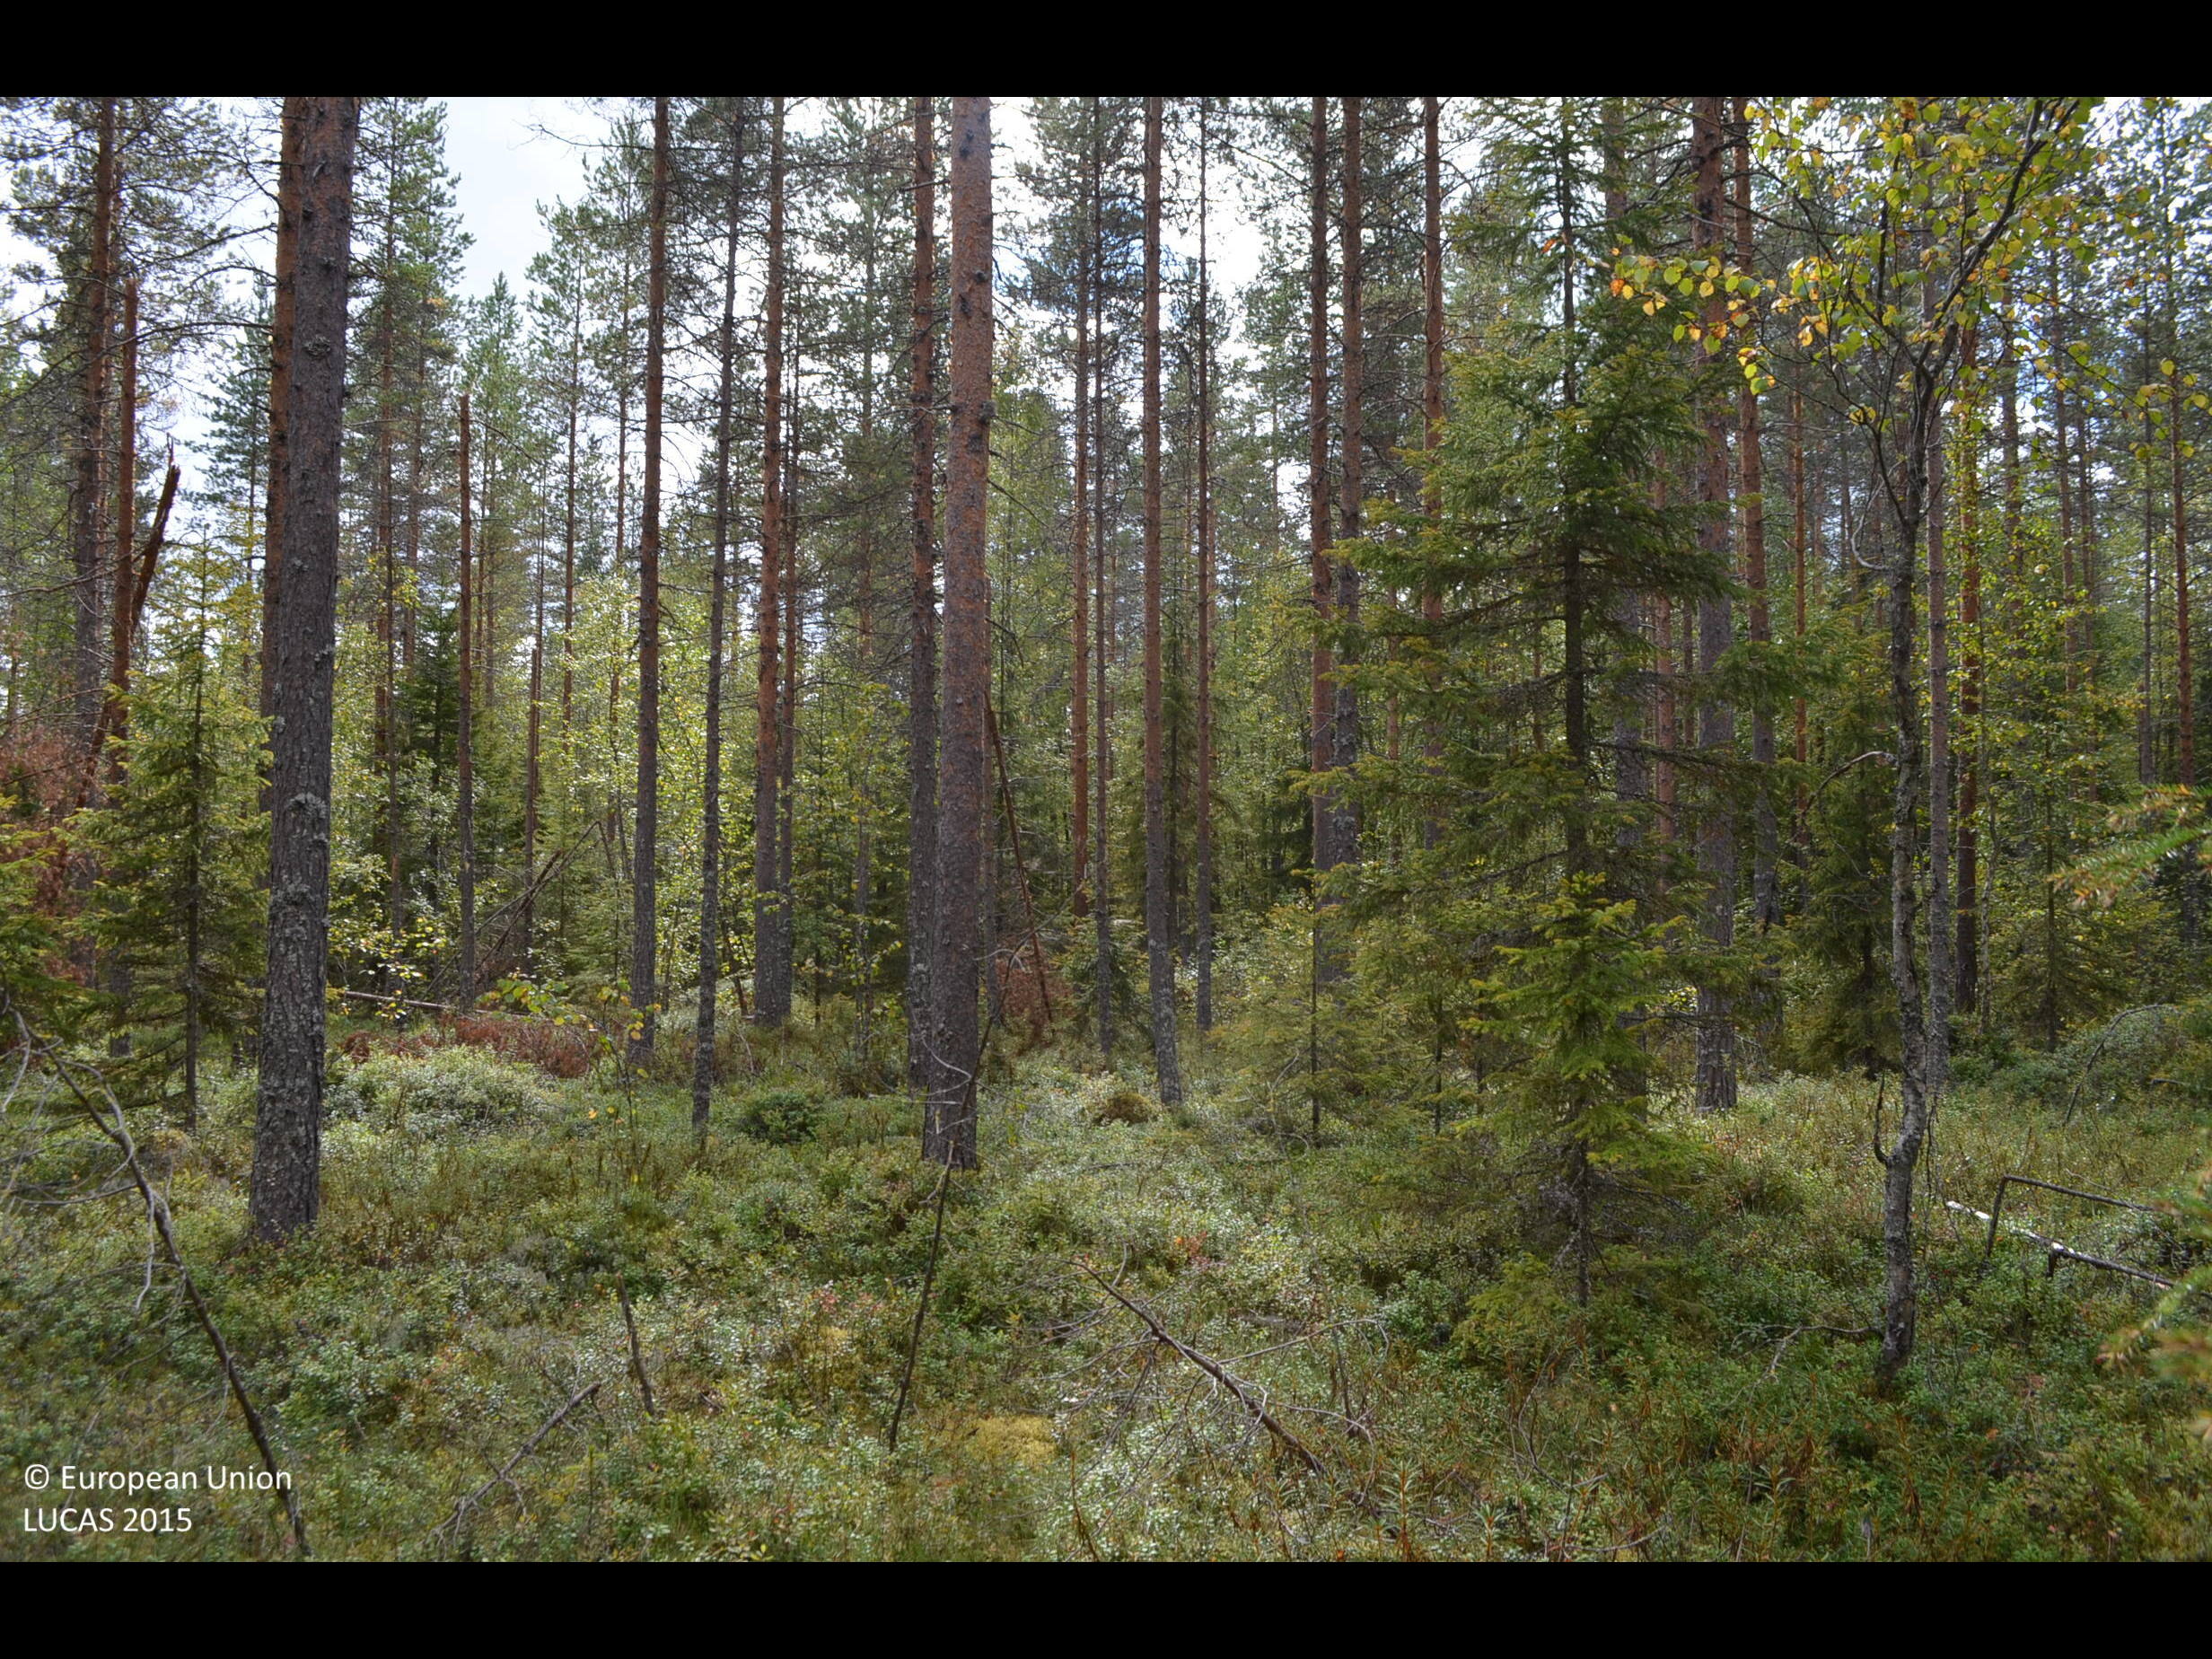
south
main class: Woodland
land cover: Pine dominated mixed woodland
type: boreal forest
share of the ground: > 75 %
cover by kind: coniferous forest trees 55 %, broadleaved forest trees 20 %, shrubs 20 %, lichens and mosses 5 %
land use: Forestry
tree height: > 5 m
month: September
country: FI
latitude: 62.7045
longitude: 24.4136
